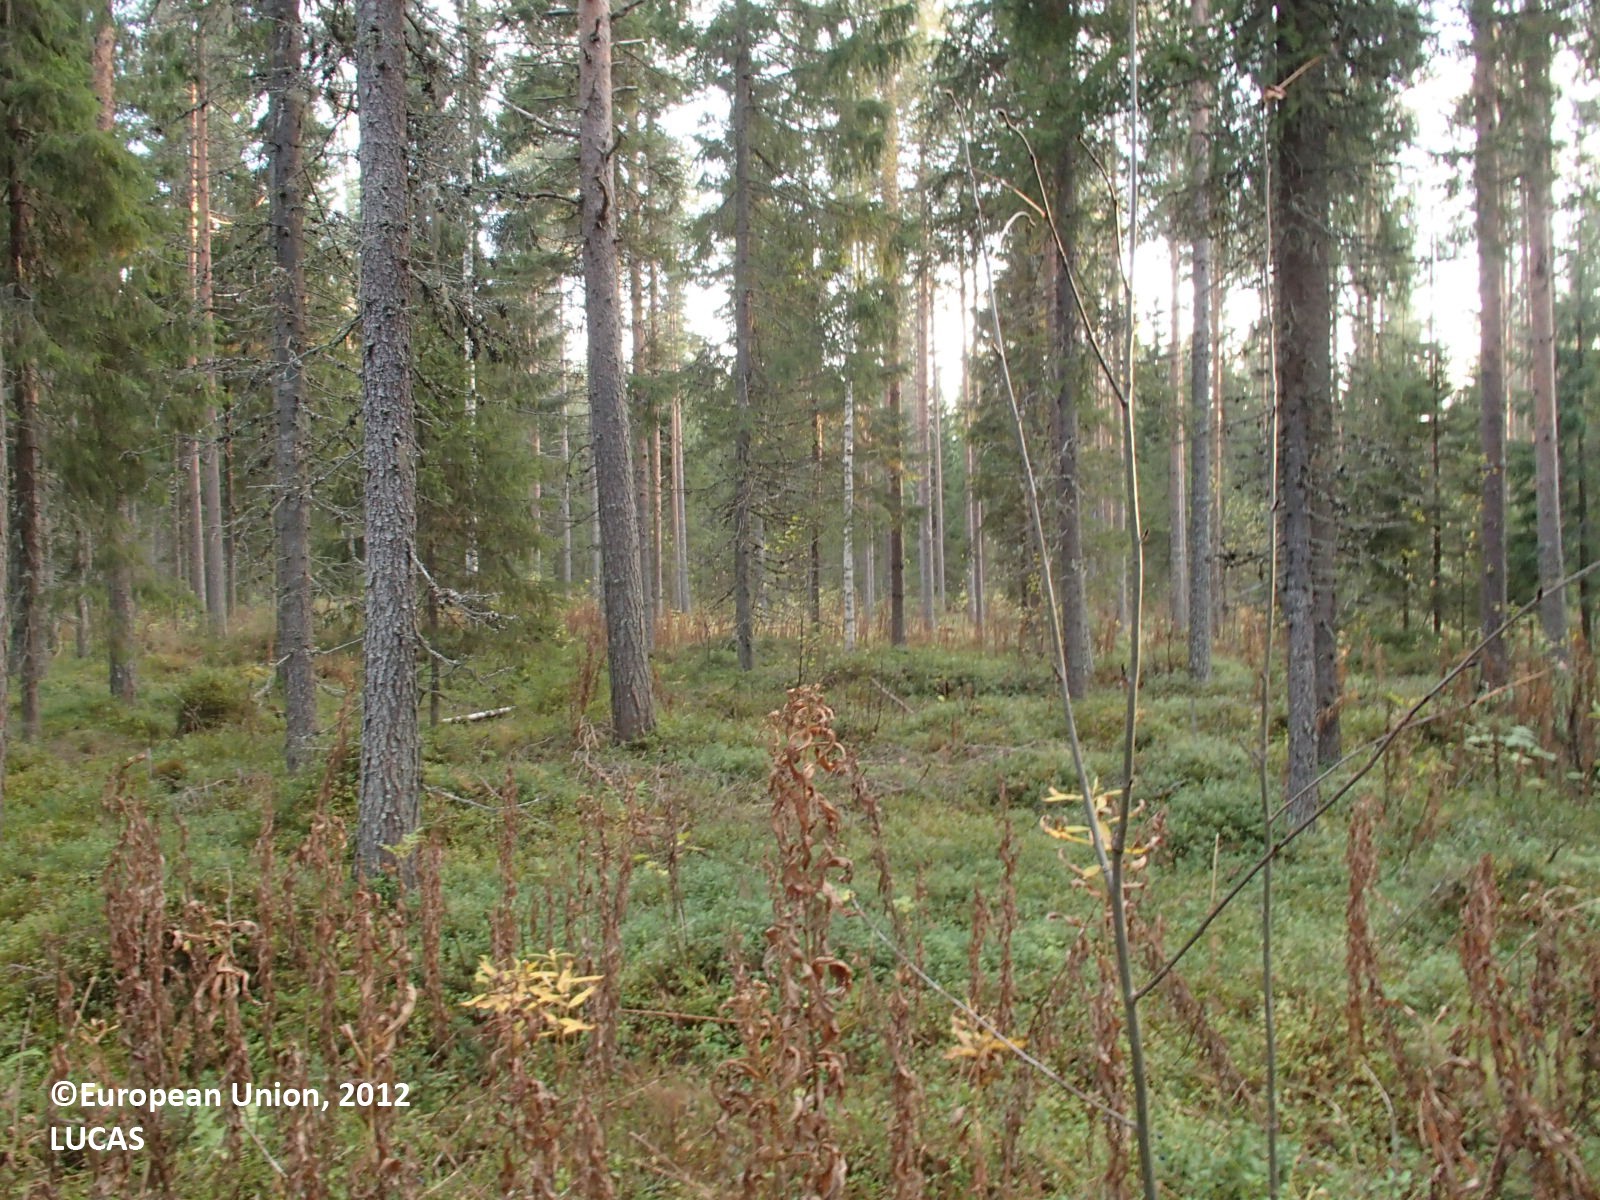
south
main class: Woodland
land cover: Spruce dominated coniferous woodland
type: boreal forest
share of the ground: > 75 %
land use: Forestry
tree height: > 5 m
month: September
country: FI
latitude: 63.5521
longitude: 26.0735
